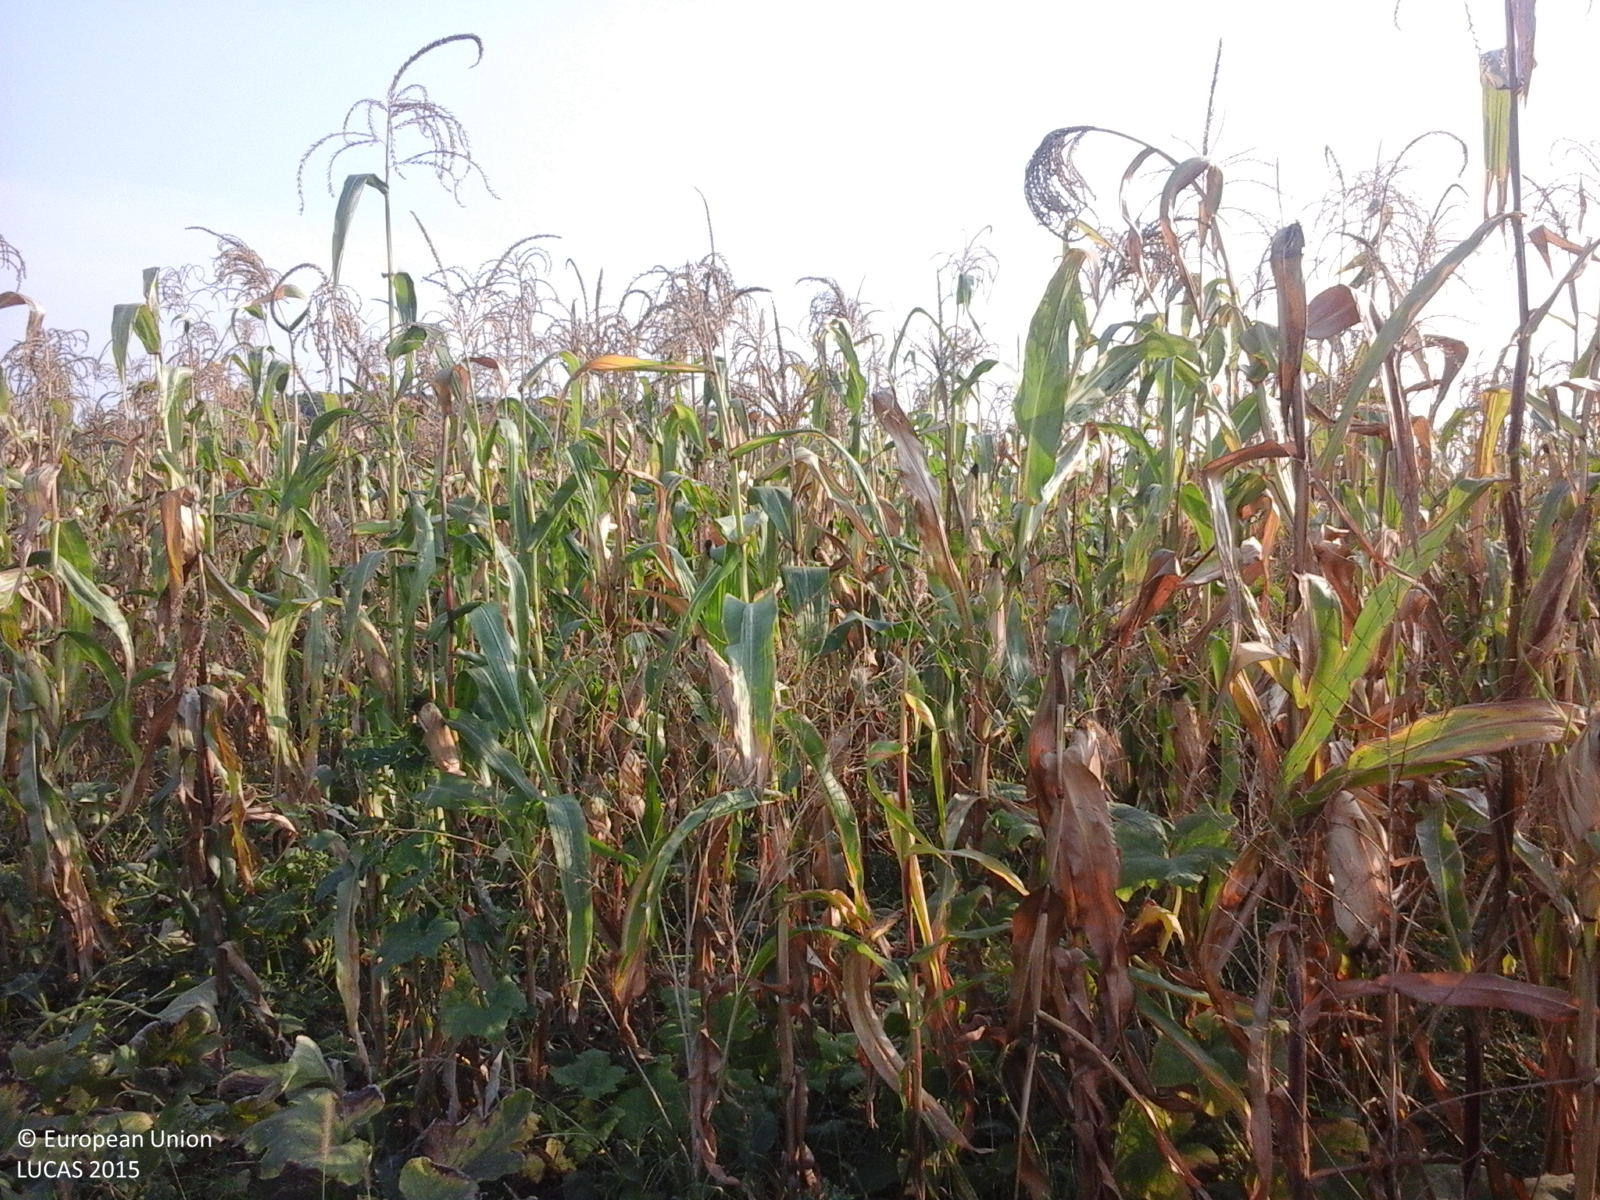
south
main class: Cropland
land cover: Potatoes
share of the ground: 10 - 25 %
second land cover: Spontaneously vegetated surfaces
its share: > 75 %
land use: Agriculture (excluding fallow land and kitchen gardens)
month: September
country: RO
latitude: 47.2007
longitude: 24.3853
